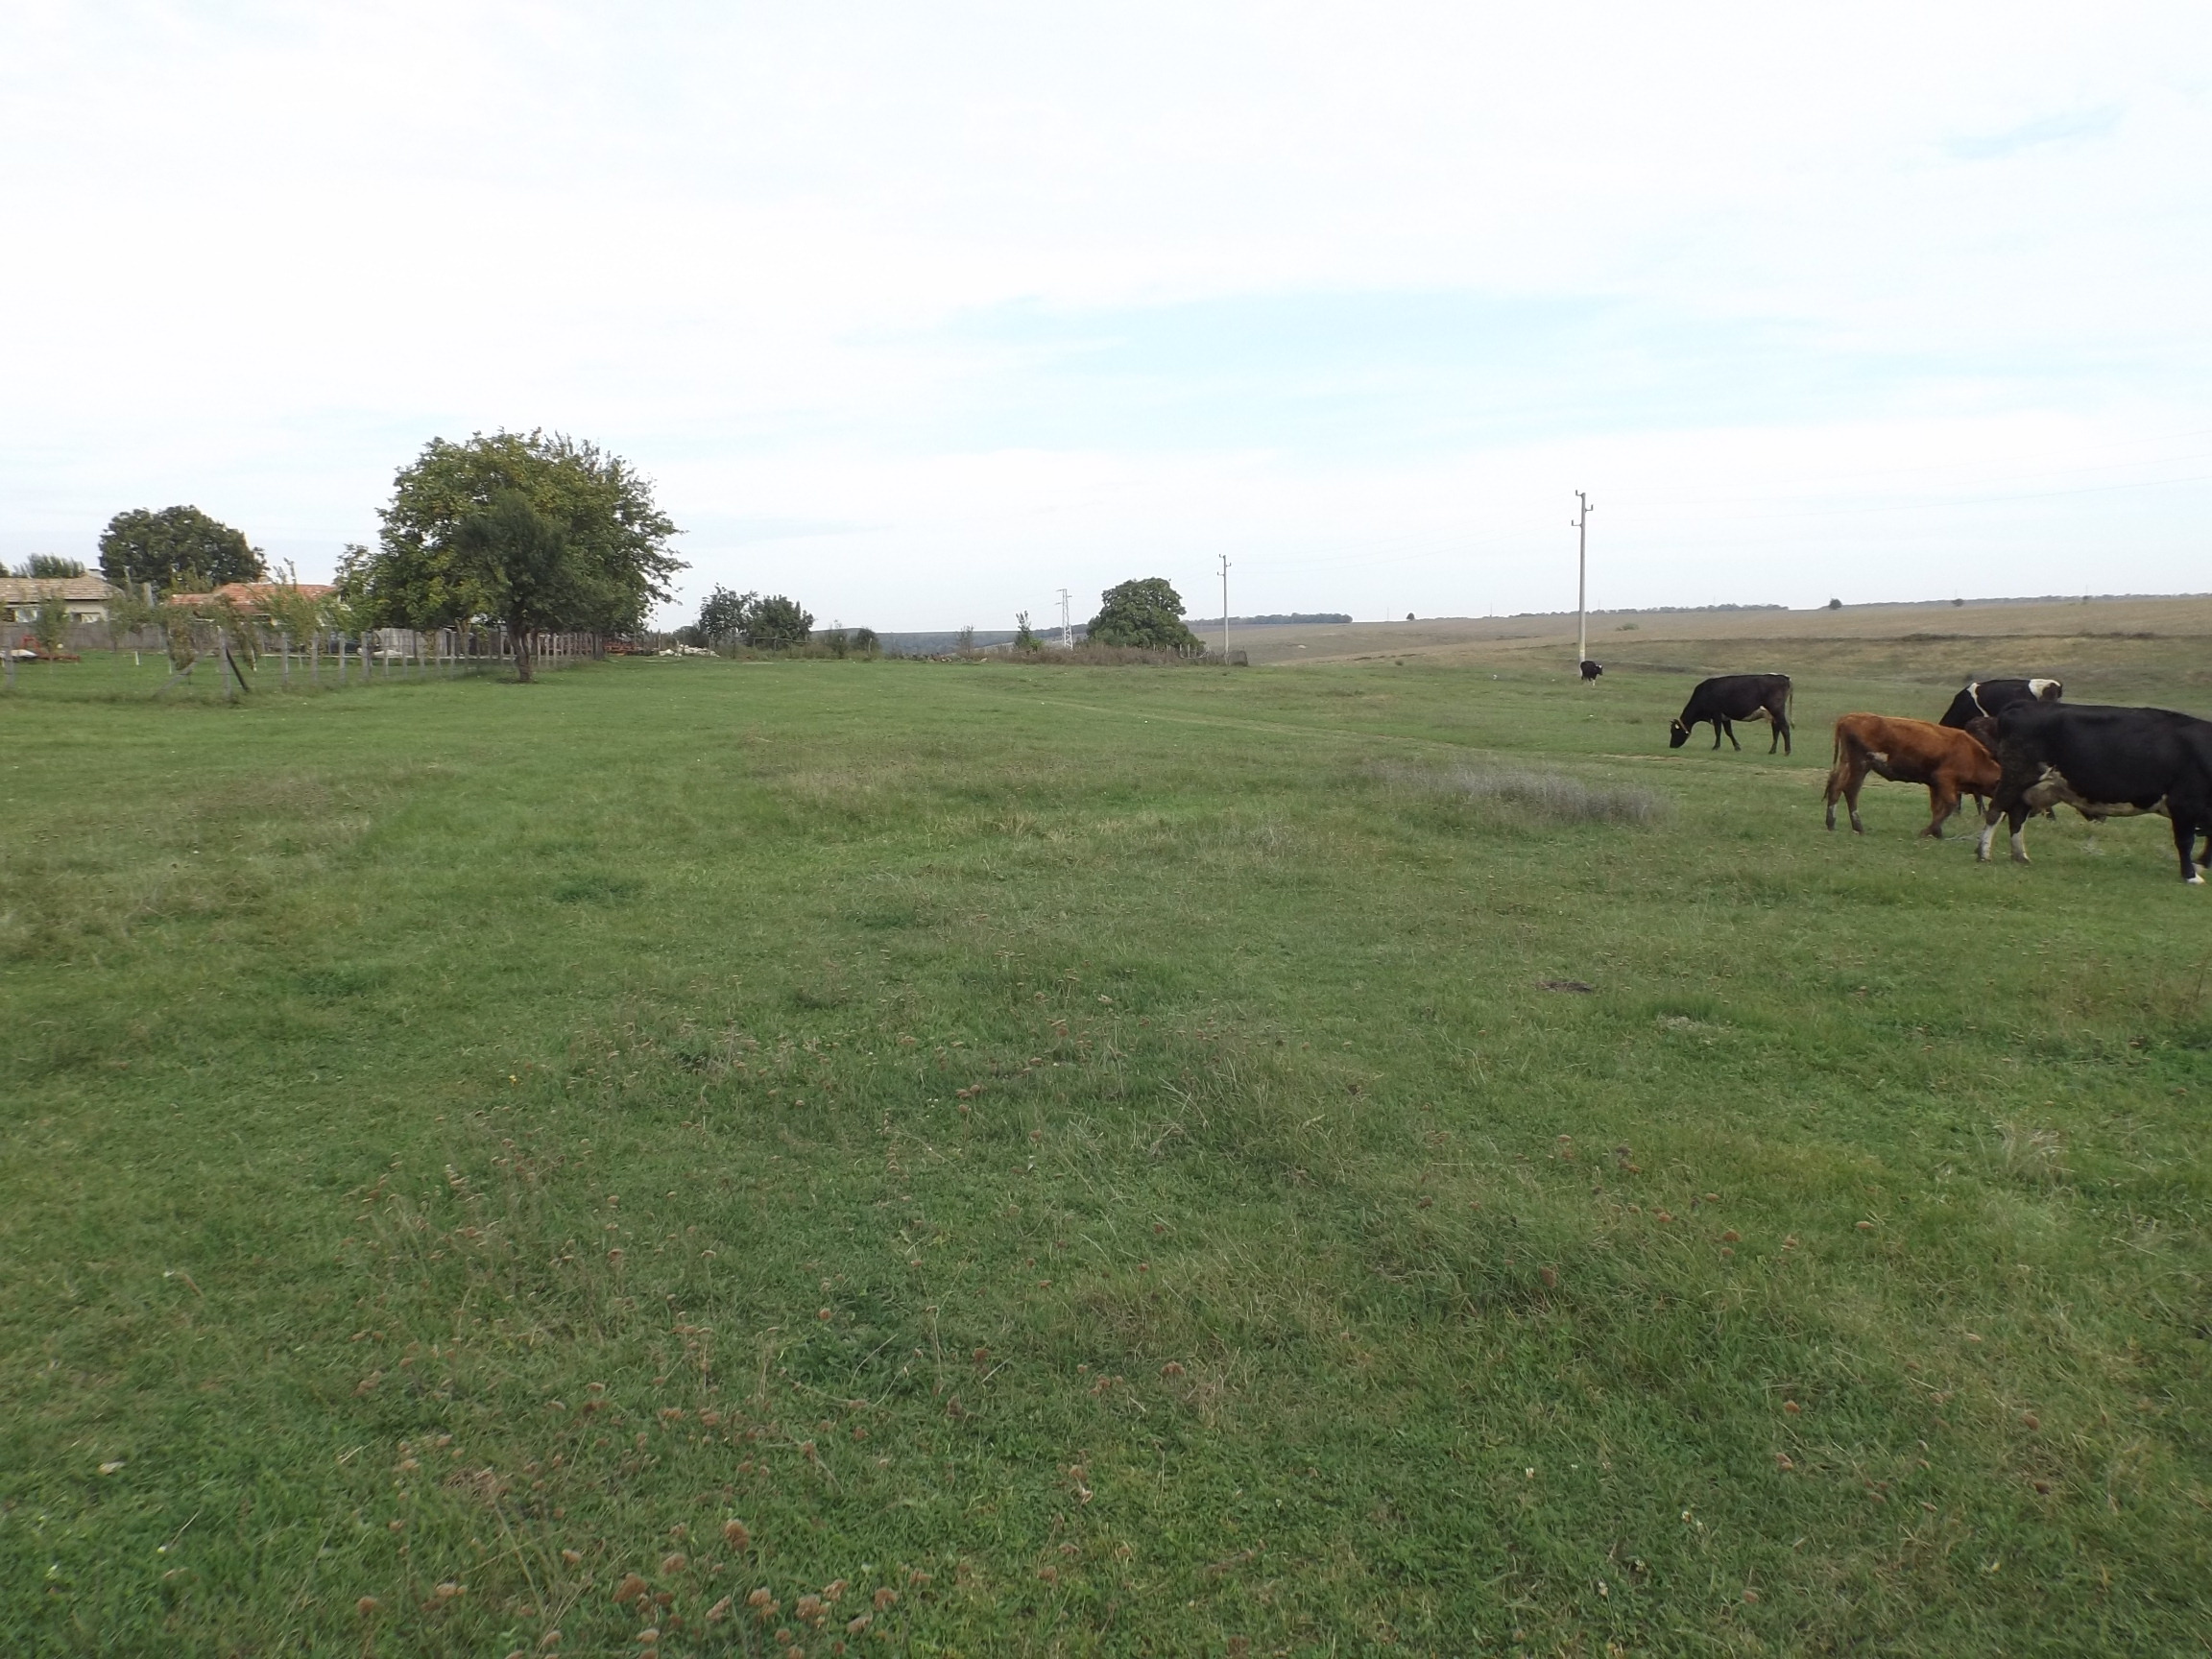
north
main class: Grassland
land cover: Grassland without tree/shrub cover
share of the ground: > 75 %
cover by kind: herbaceous plants 100 %
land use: Agriculture (excluding fallow land and kitchen gardens)
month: October
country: BG
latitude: 43.9141
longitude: 26.8680
